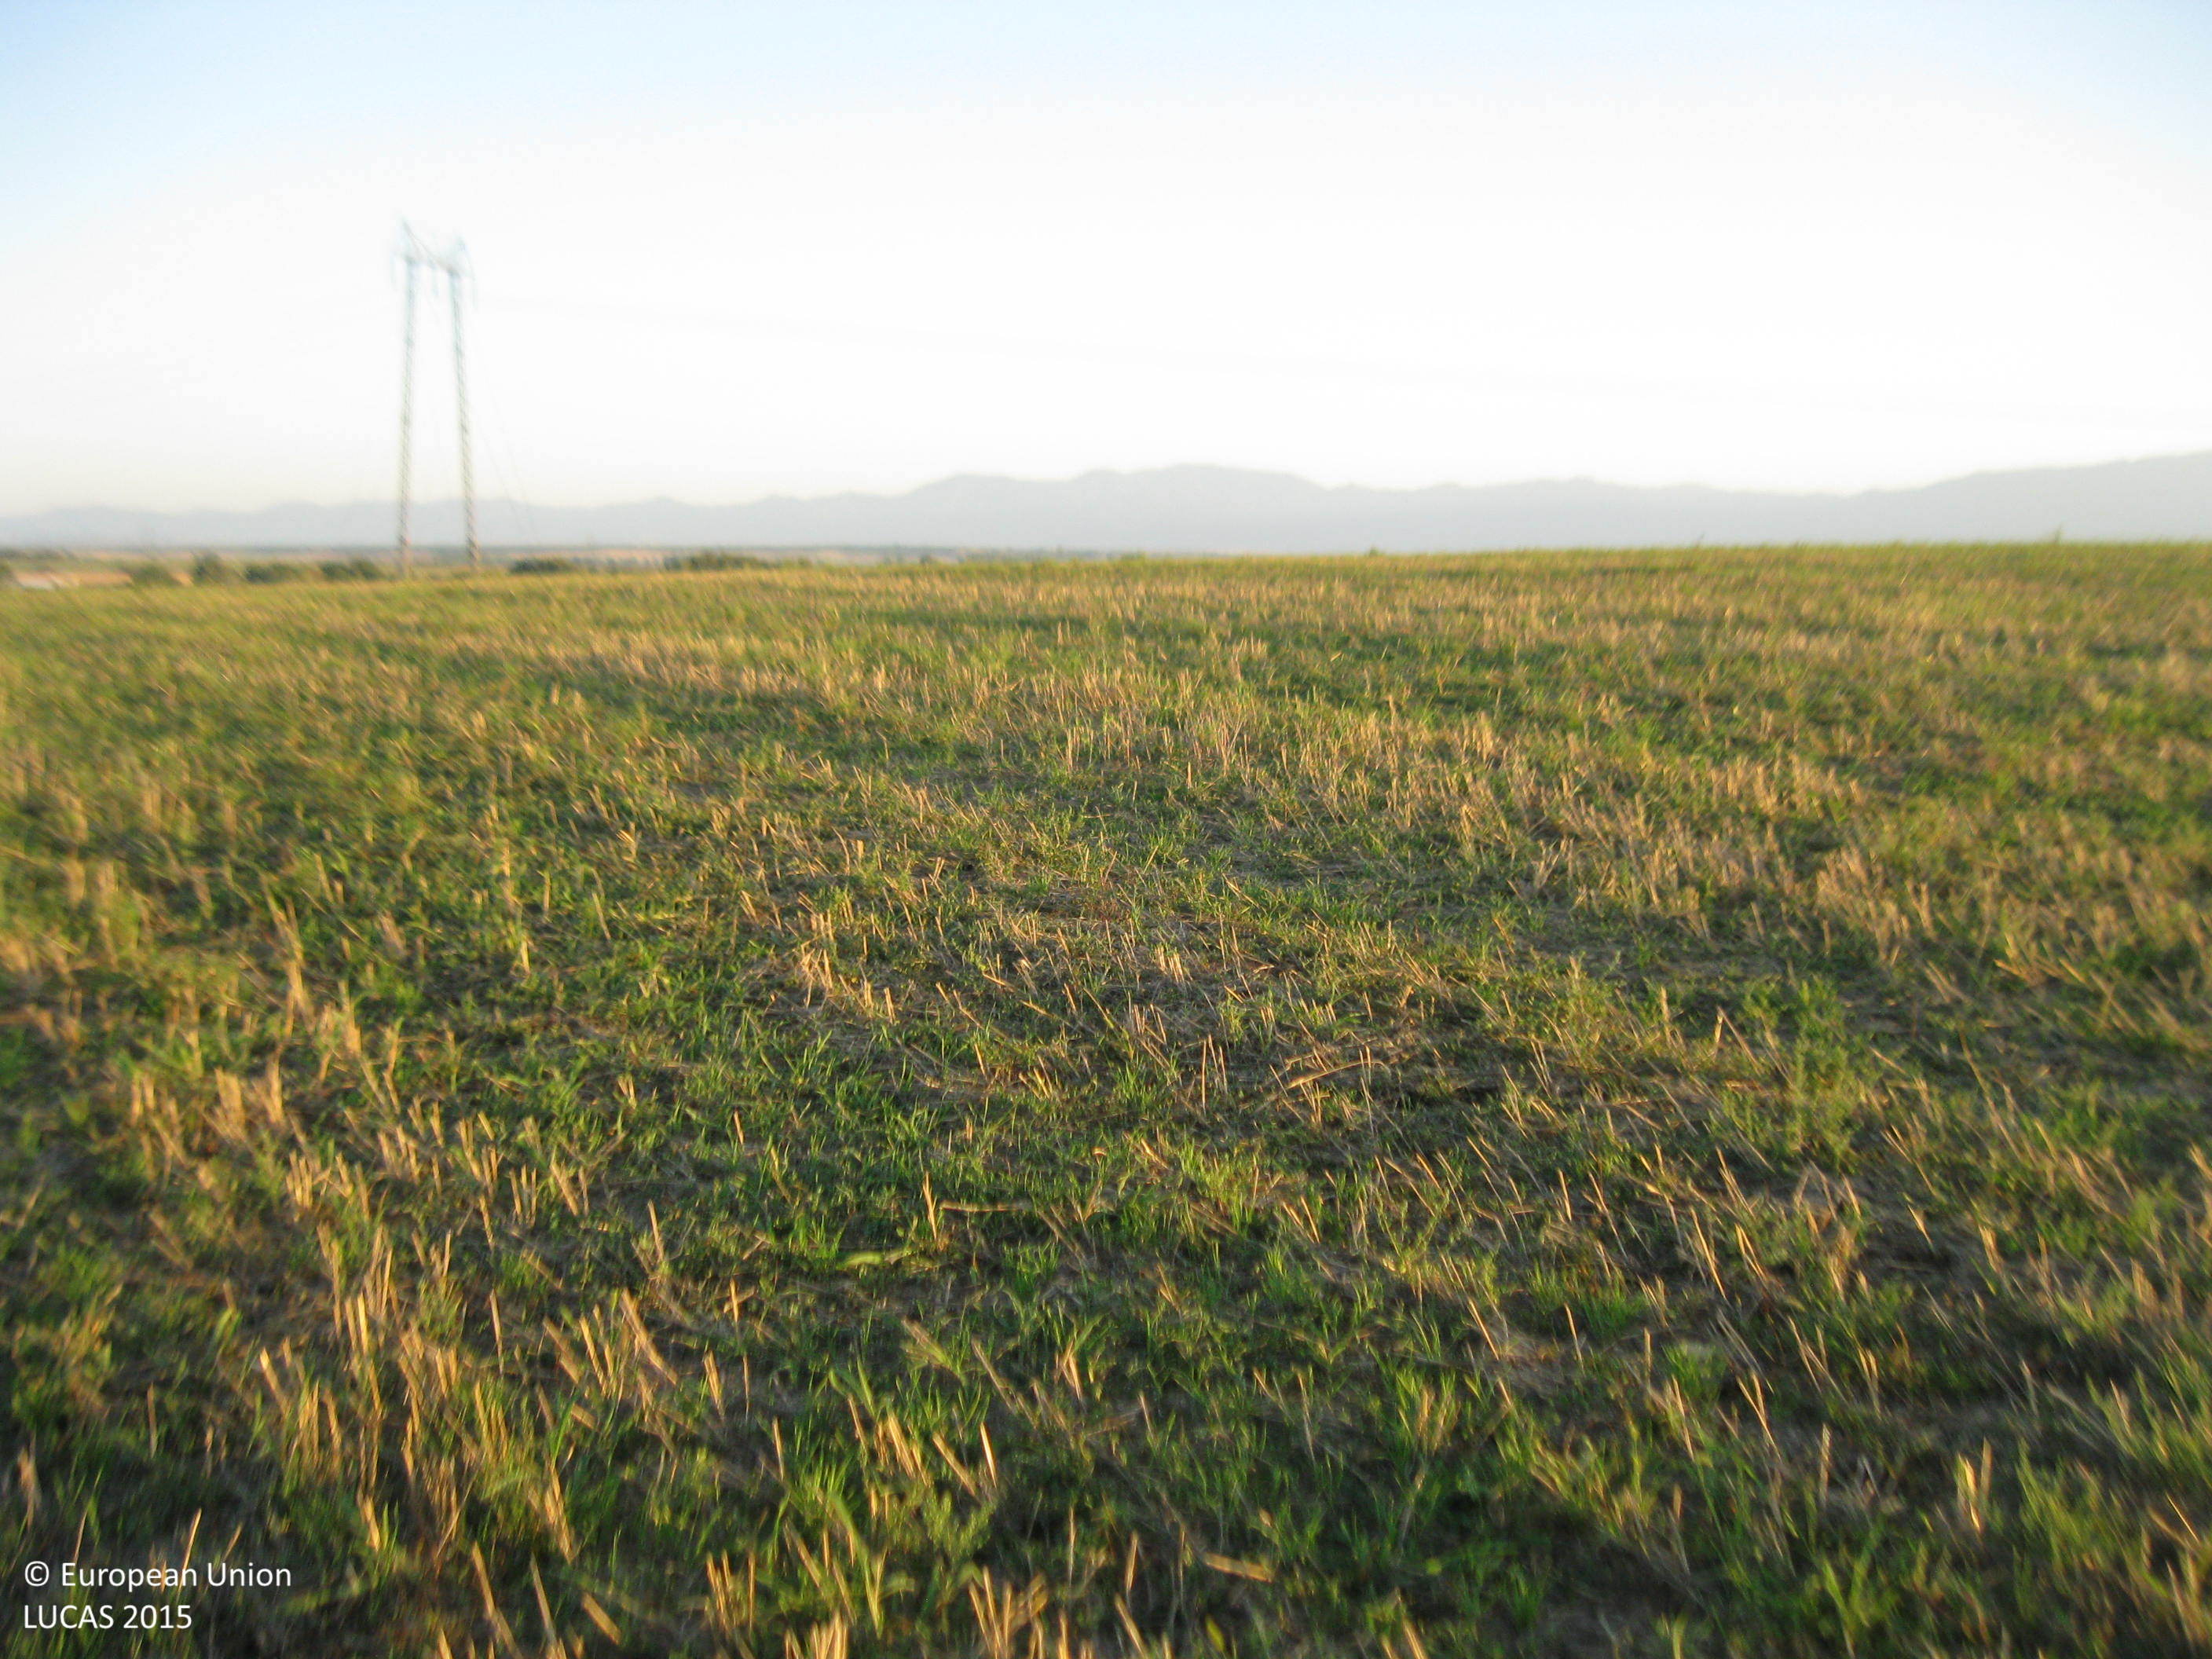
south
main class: Cropland
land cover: Common wheat
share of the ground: 25 - 50 %
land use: Agriculture (excluding fallow land and kitchen gardens)
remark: Harvested field
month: September
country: BG
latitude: 42.0963
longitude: 25.0123
